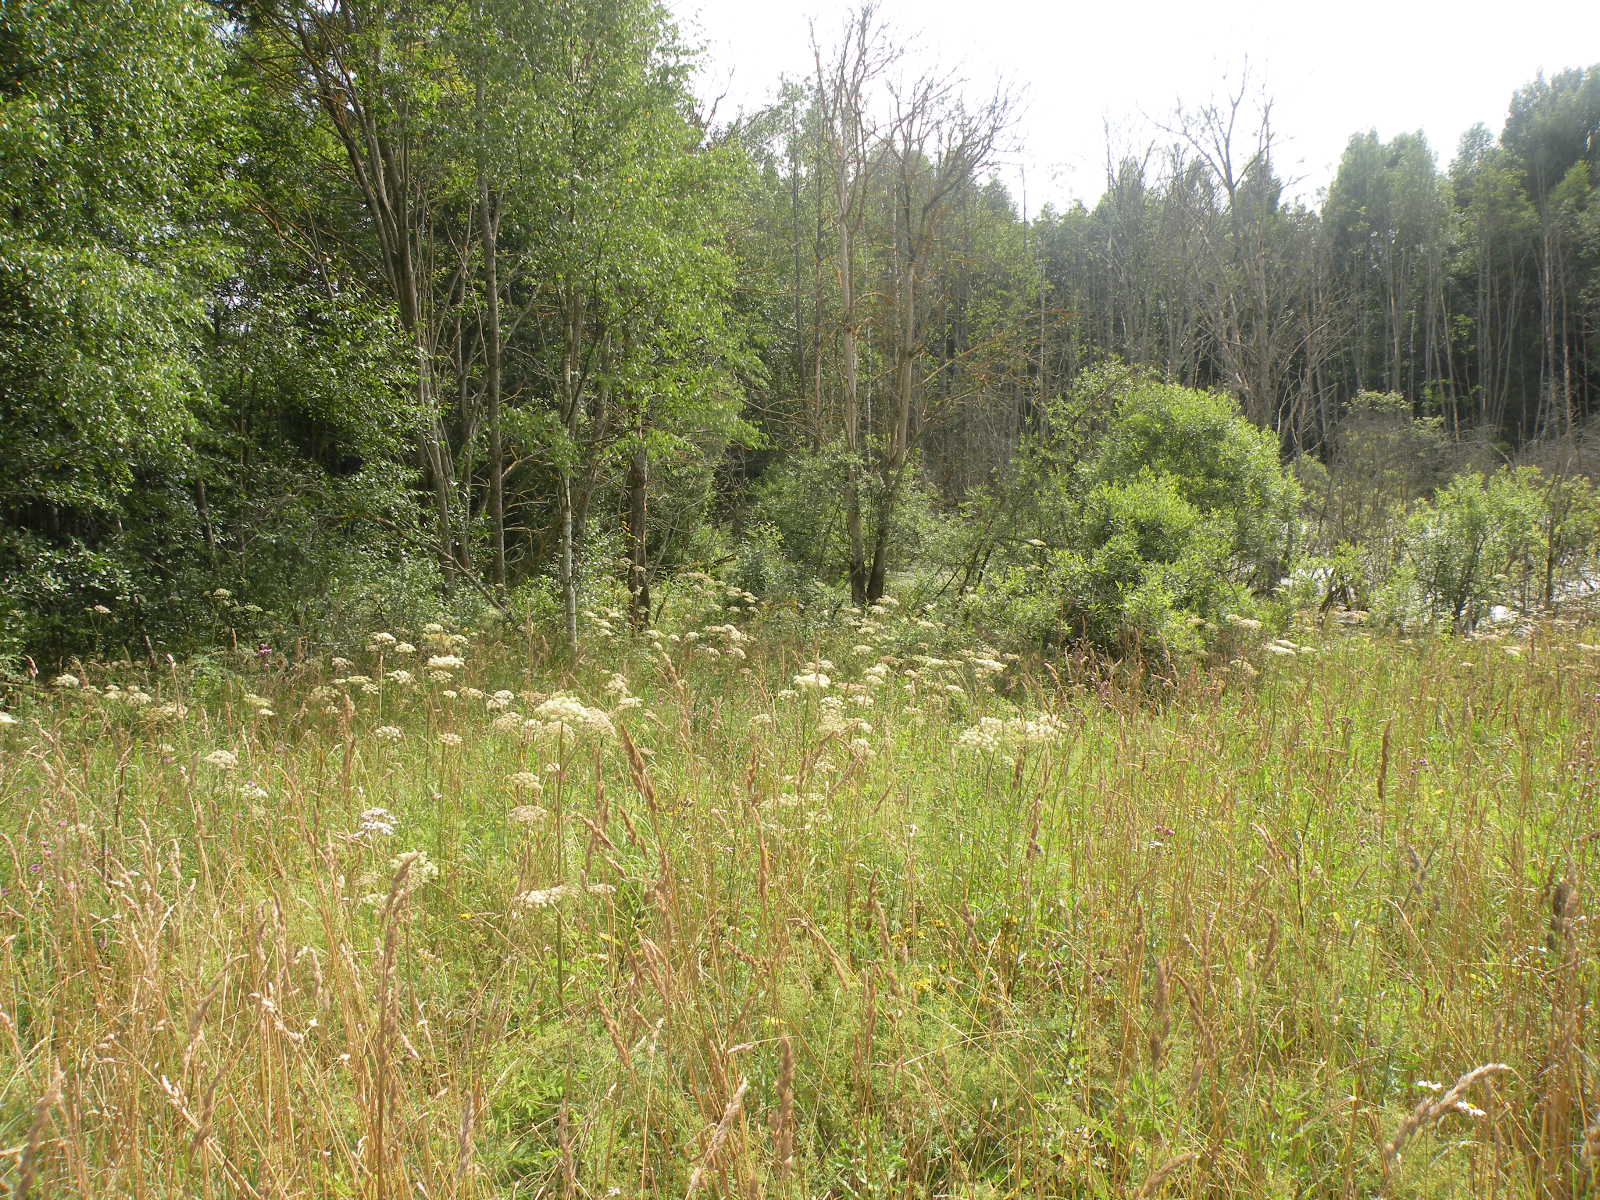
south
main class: Grassland
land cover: Grassland with sparse tree/shrub cover
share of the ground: > 75 %
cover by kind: herbaceous plants 85 %, shrubs 10 %, coniferous forest trees 5 %
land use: Semi-natural and natural areas not in use
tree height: < 5 m
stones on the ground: < 10 %
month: July
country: LV
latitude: 55.8225
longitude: 26.9399
